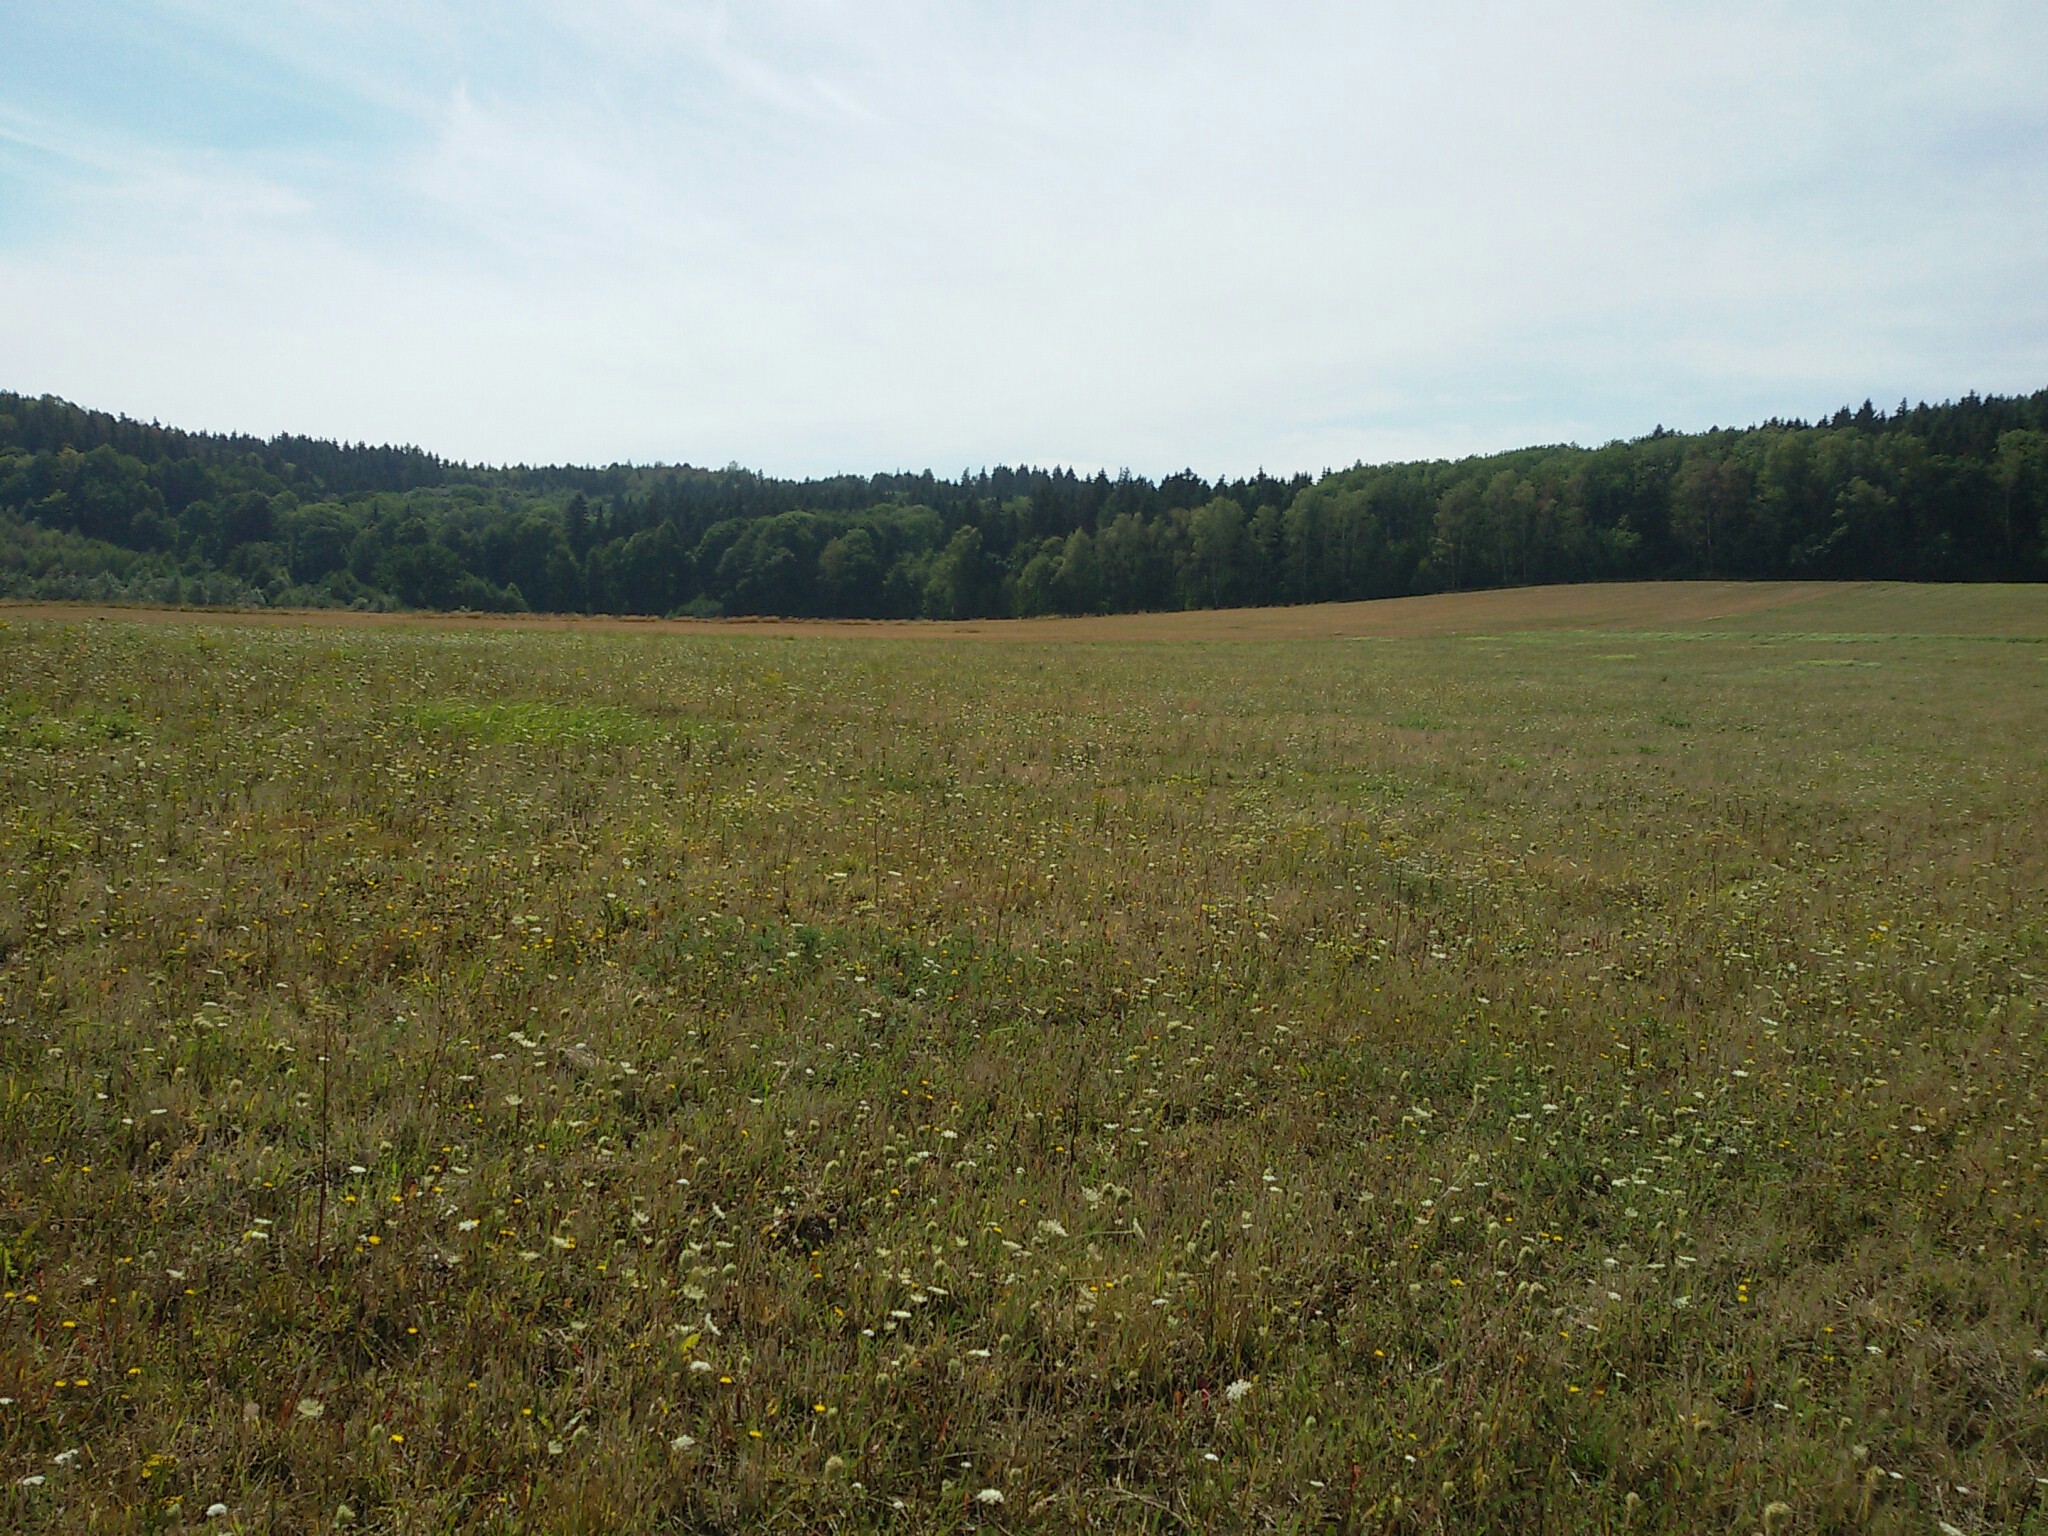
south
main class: Grassland
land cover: Grassland without tree/shrub cover
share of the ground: > 75 %
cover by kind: herbaceous plants 100 %
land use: Agriculture (excluding fallow land and kitchen gardens)
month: August
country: PL
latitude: 50.3847
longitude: 16.6889
